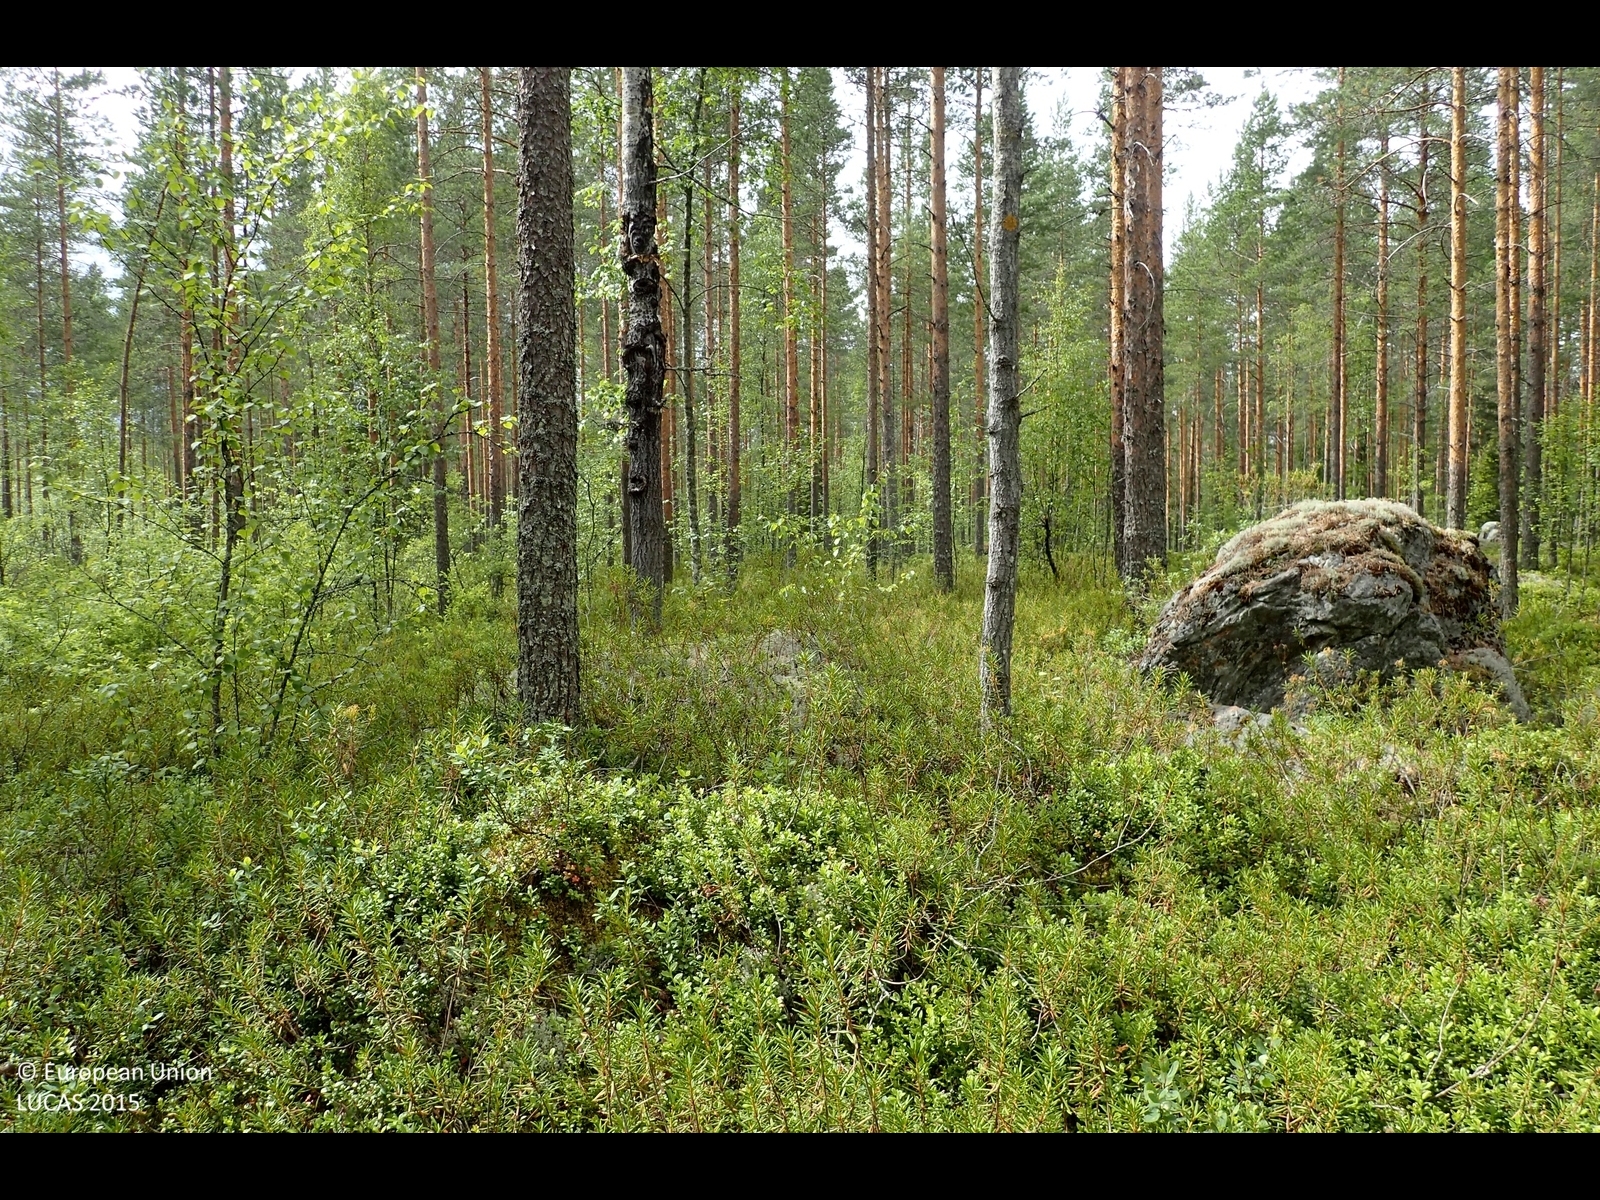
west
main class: Woodland
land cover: Pine dominated coniferous woodland
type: boreal forest
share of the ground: 50 - 75 %
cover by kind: coniferous forest trees 45 %, shrubs 45 %, broadleaved forest trees 5 %, lichens and mosses 5 %
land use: Forestry
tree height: > 5 m
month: July
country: FI
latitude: 62.6067
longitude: 23.4933
